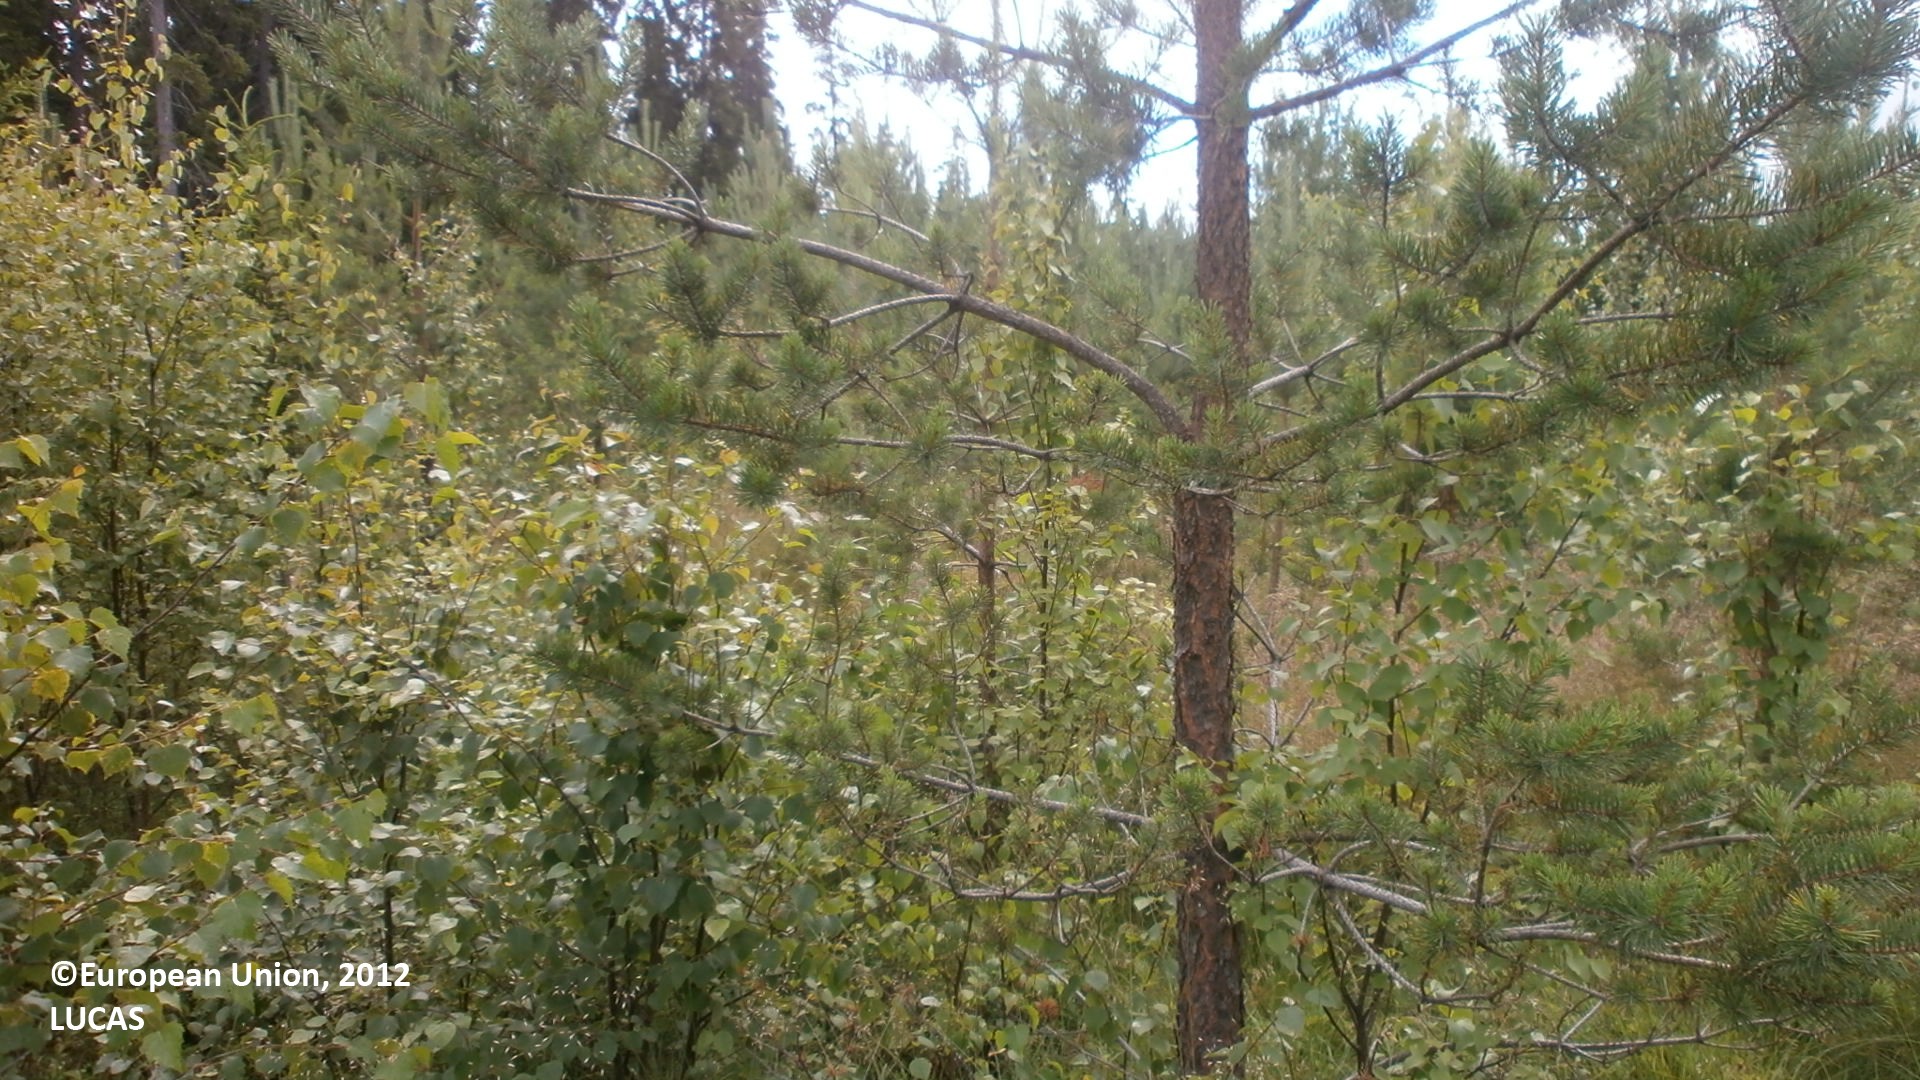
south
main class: Woodland
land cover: Pine dominated mixed woodland
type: boreal forest
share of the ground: 50 - 75 %
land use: Forestry
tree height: > 5 m
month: July
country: FI
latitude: 64.0134
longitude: 23.7873
